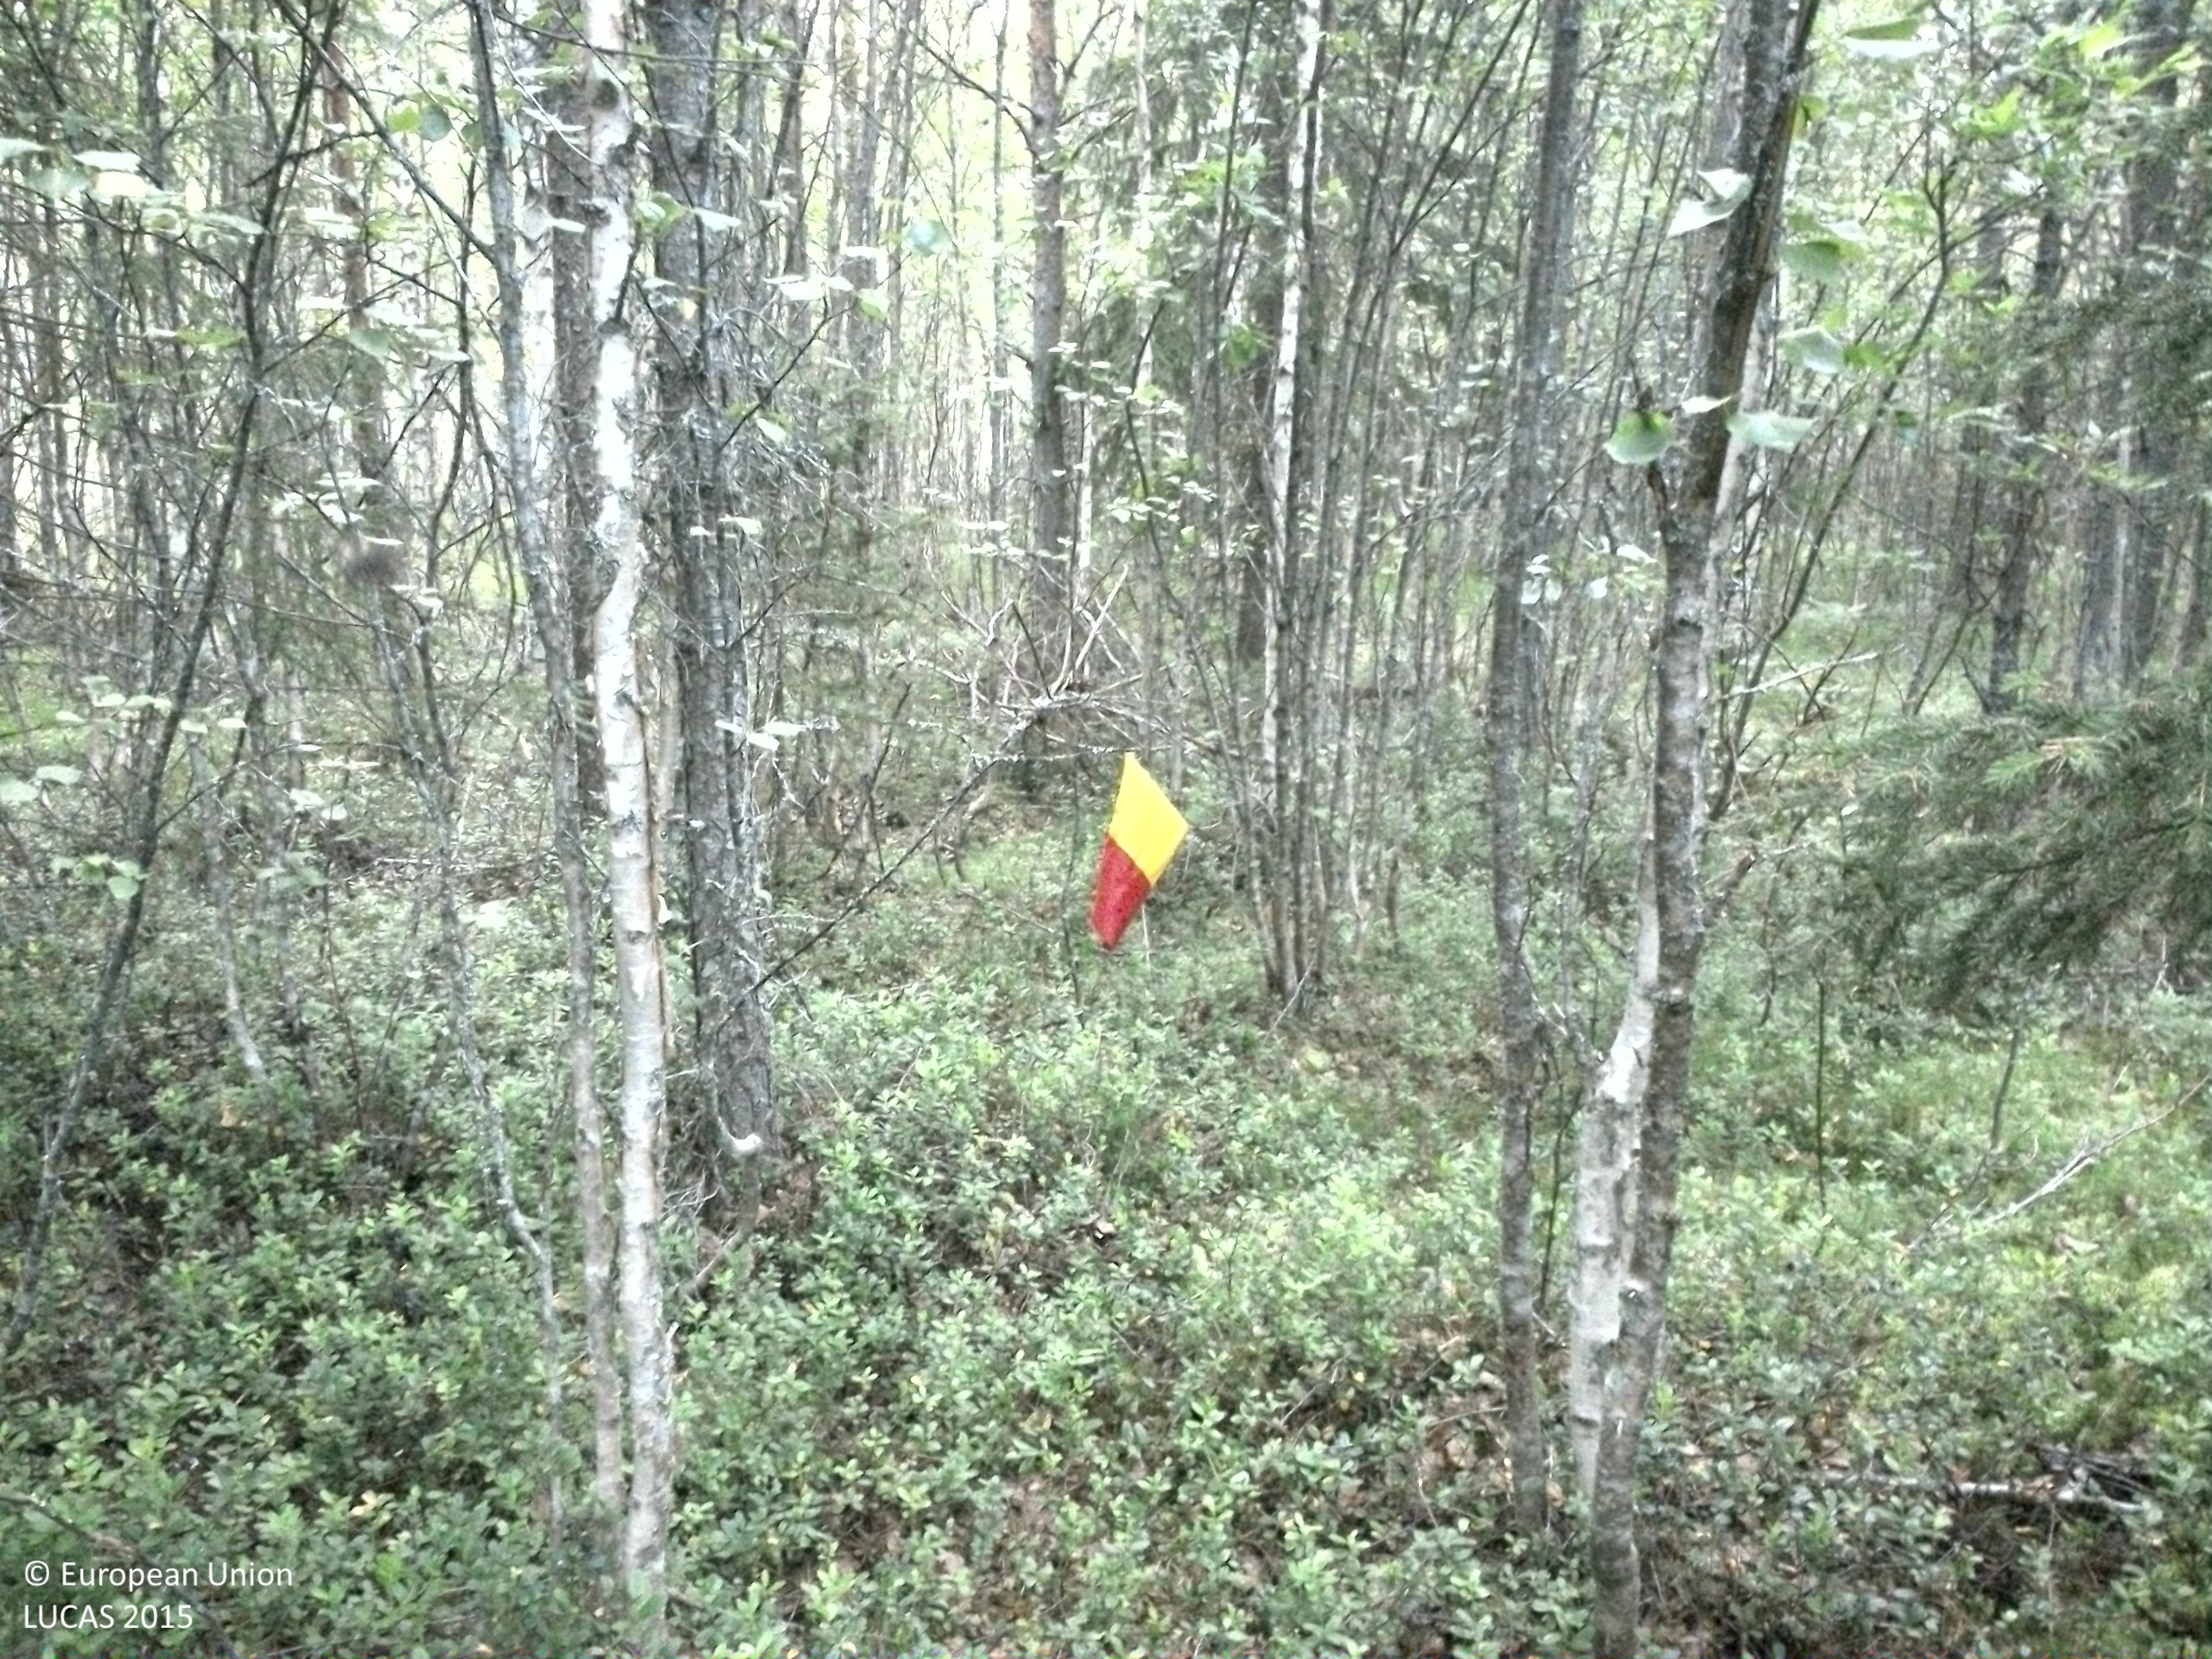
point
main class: Woodland
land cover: Other mixed woodland
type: boreal forest
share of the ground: > 75 %
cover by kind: broadleaved forest trees 50 %, coniferous forest trees 30 %, shrubs 10 %, lichens and mosses 10 %
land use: Forestry
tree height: > 5 m
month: August
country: SE
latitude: 63.6328
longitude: 16.4513
